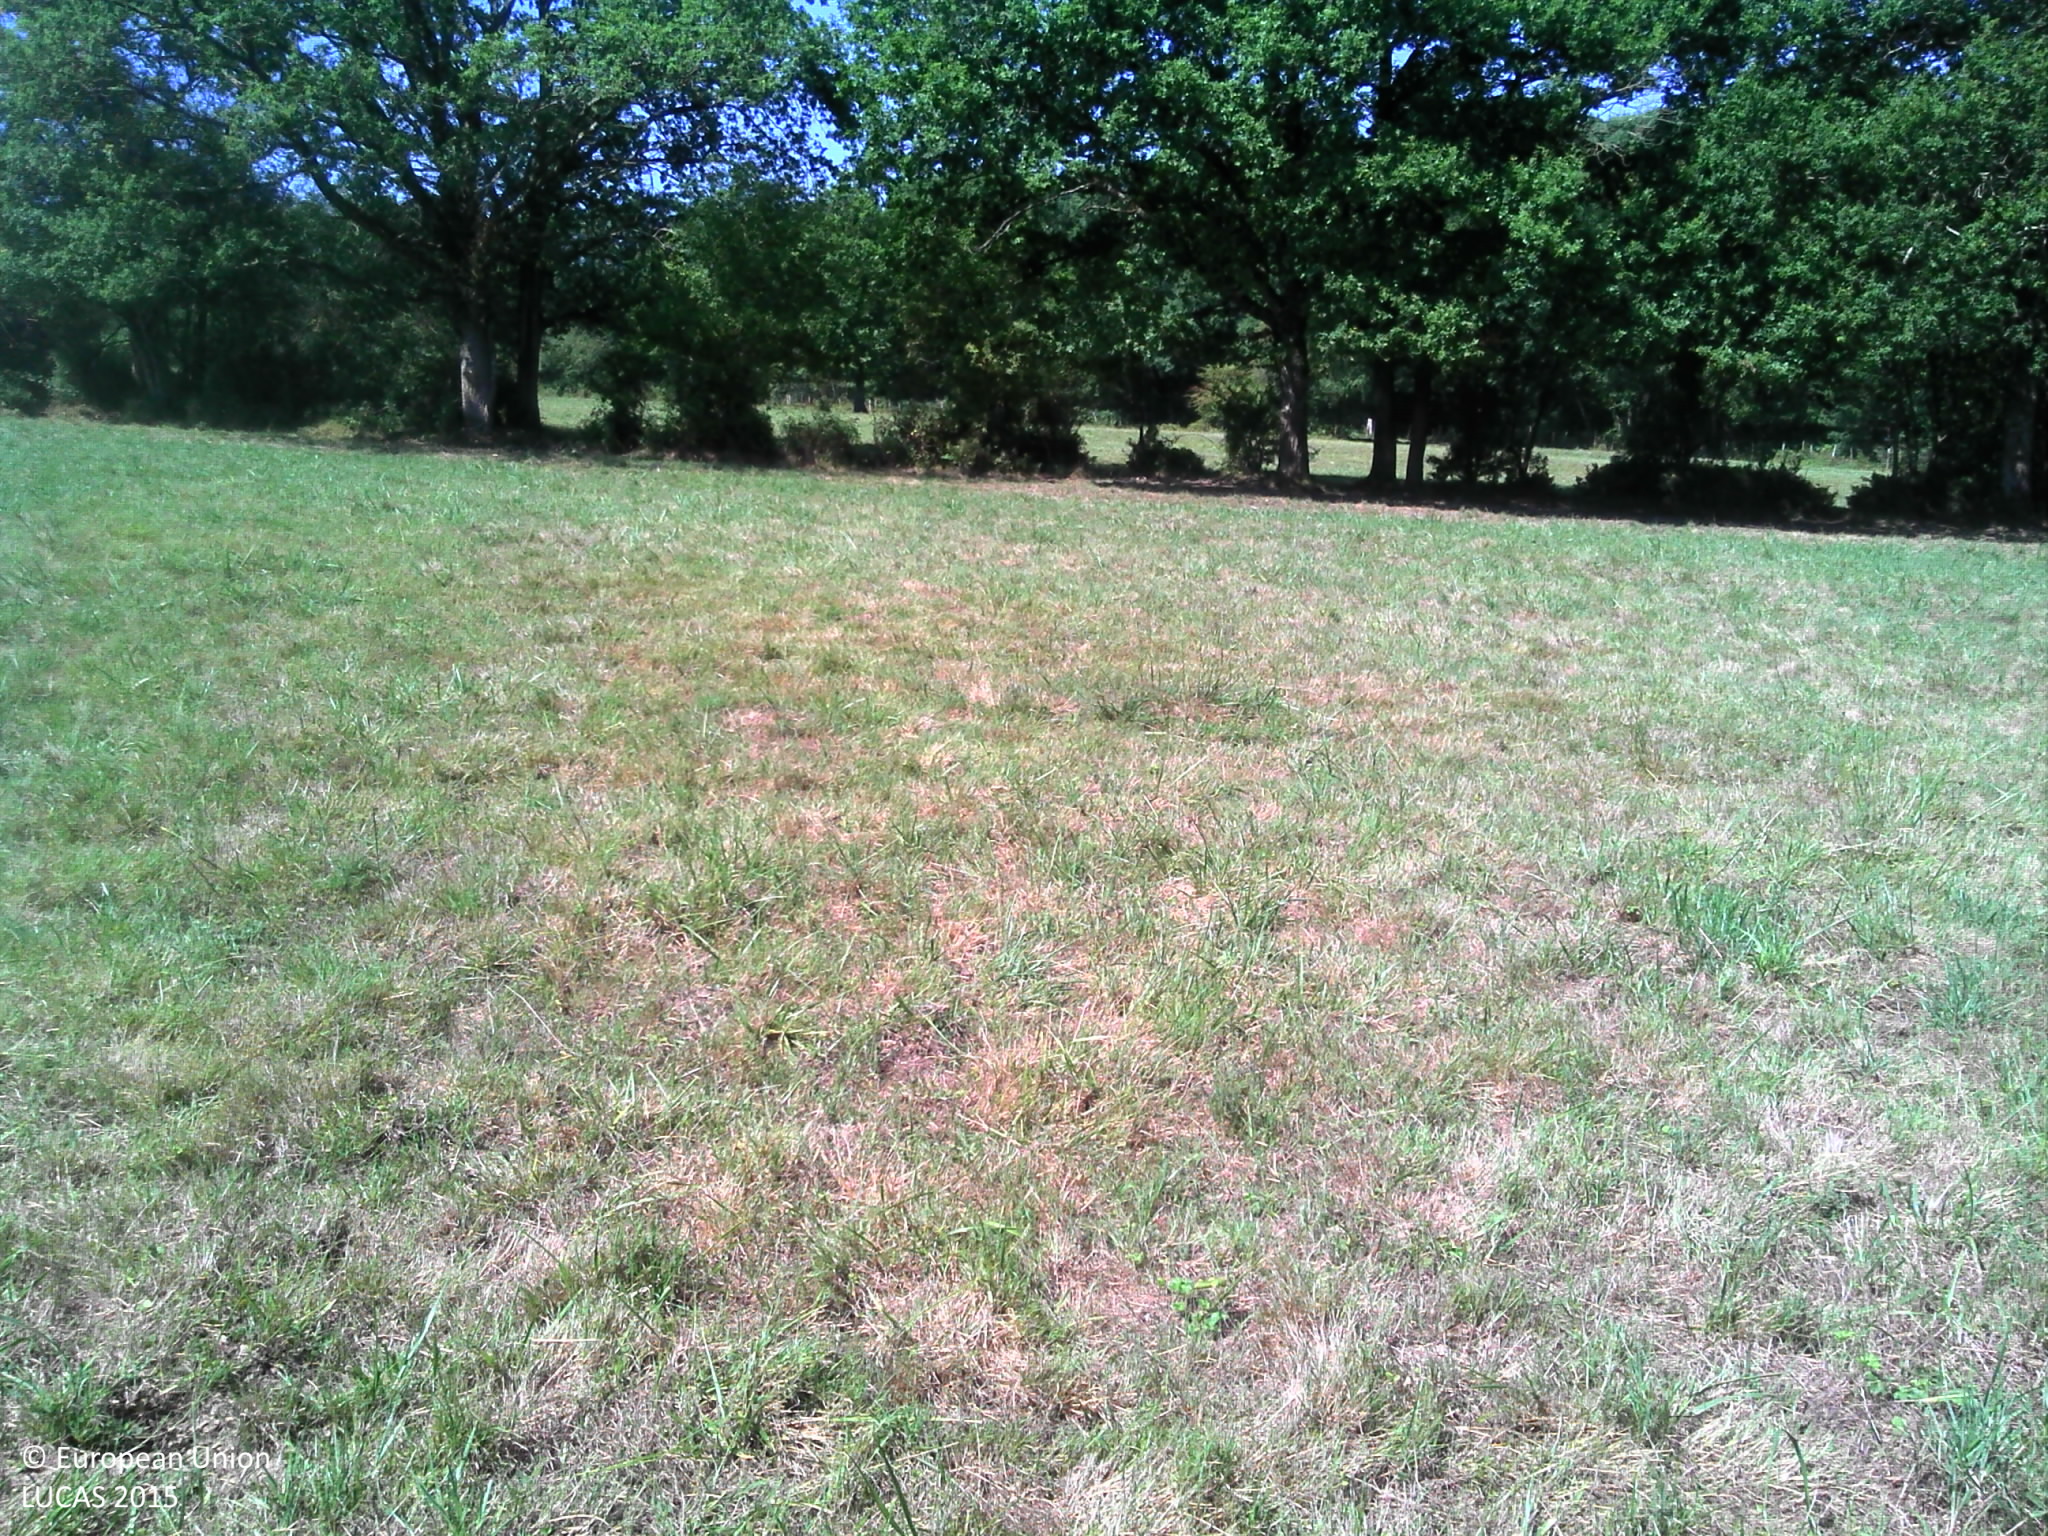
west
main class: Grassland
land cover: Grassland without tree/shrub cover
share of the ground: > 75 %
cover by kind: herbaceous plants 100 %
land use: Agriculture (excluding fallow land and kitchen gardens)
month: August
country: FR
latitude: 46.2163
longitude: 0.8997
